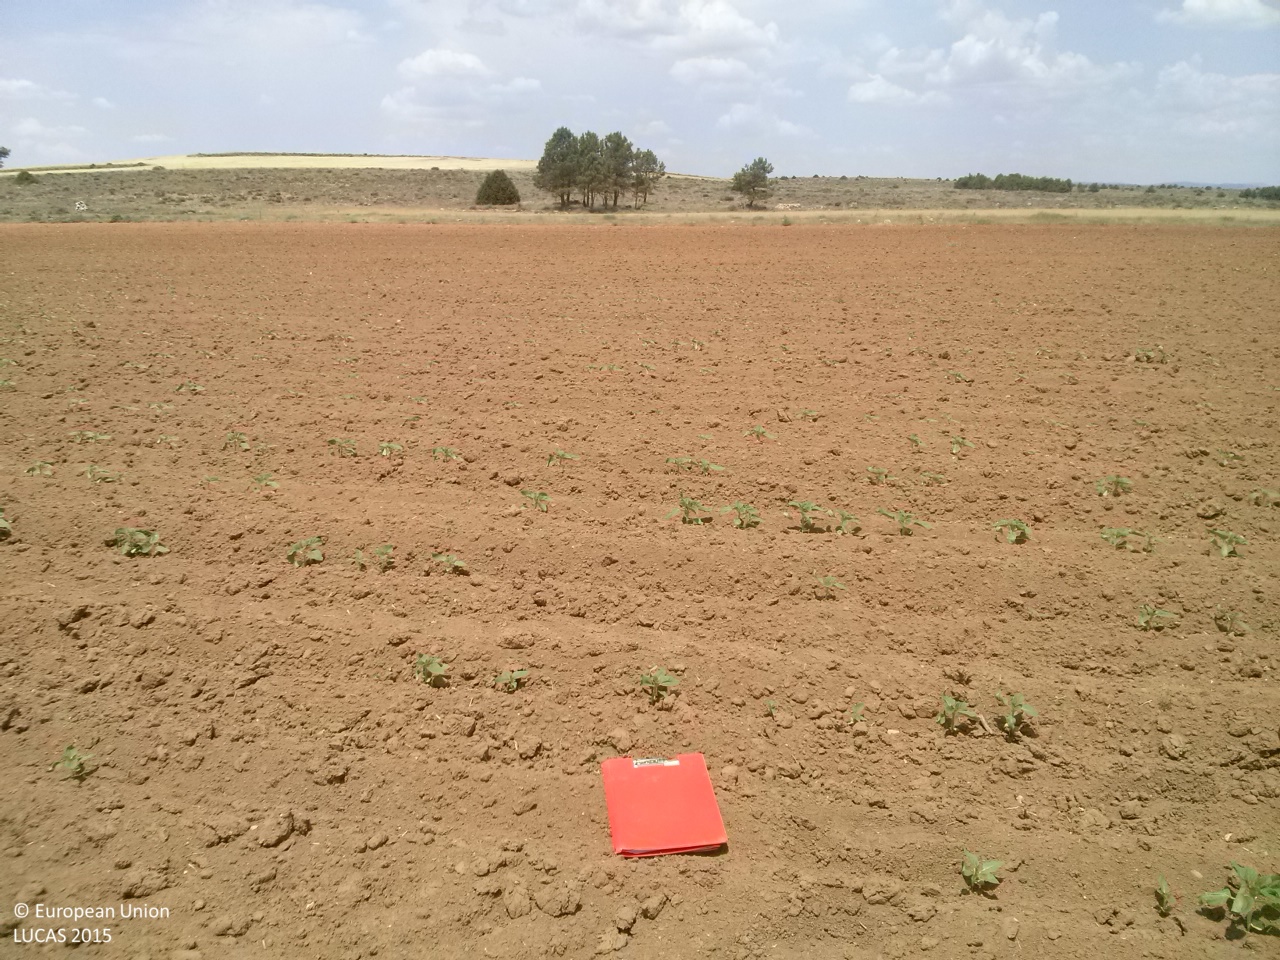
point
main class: Cropland
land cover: Sunflower
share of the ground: < 10 %
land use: Agriculture (excluding fallow land and kitchen gardens)
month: June
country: ES
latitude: 39.9188
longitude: -1.7924
